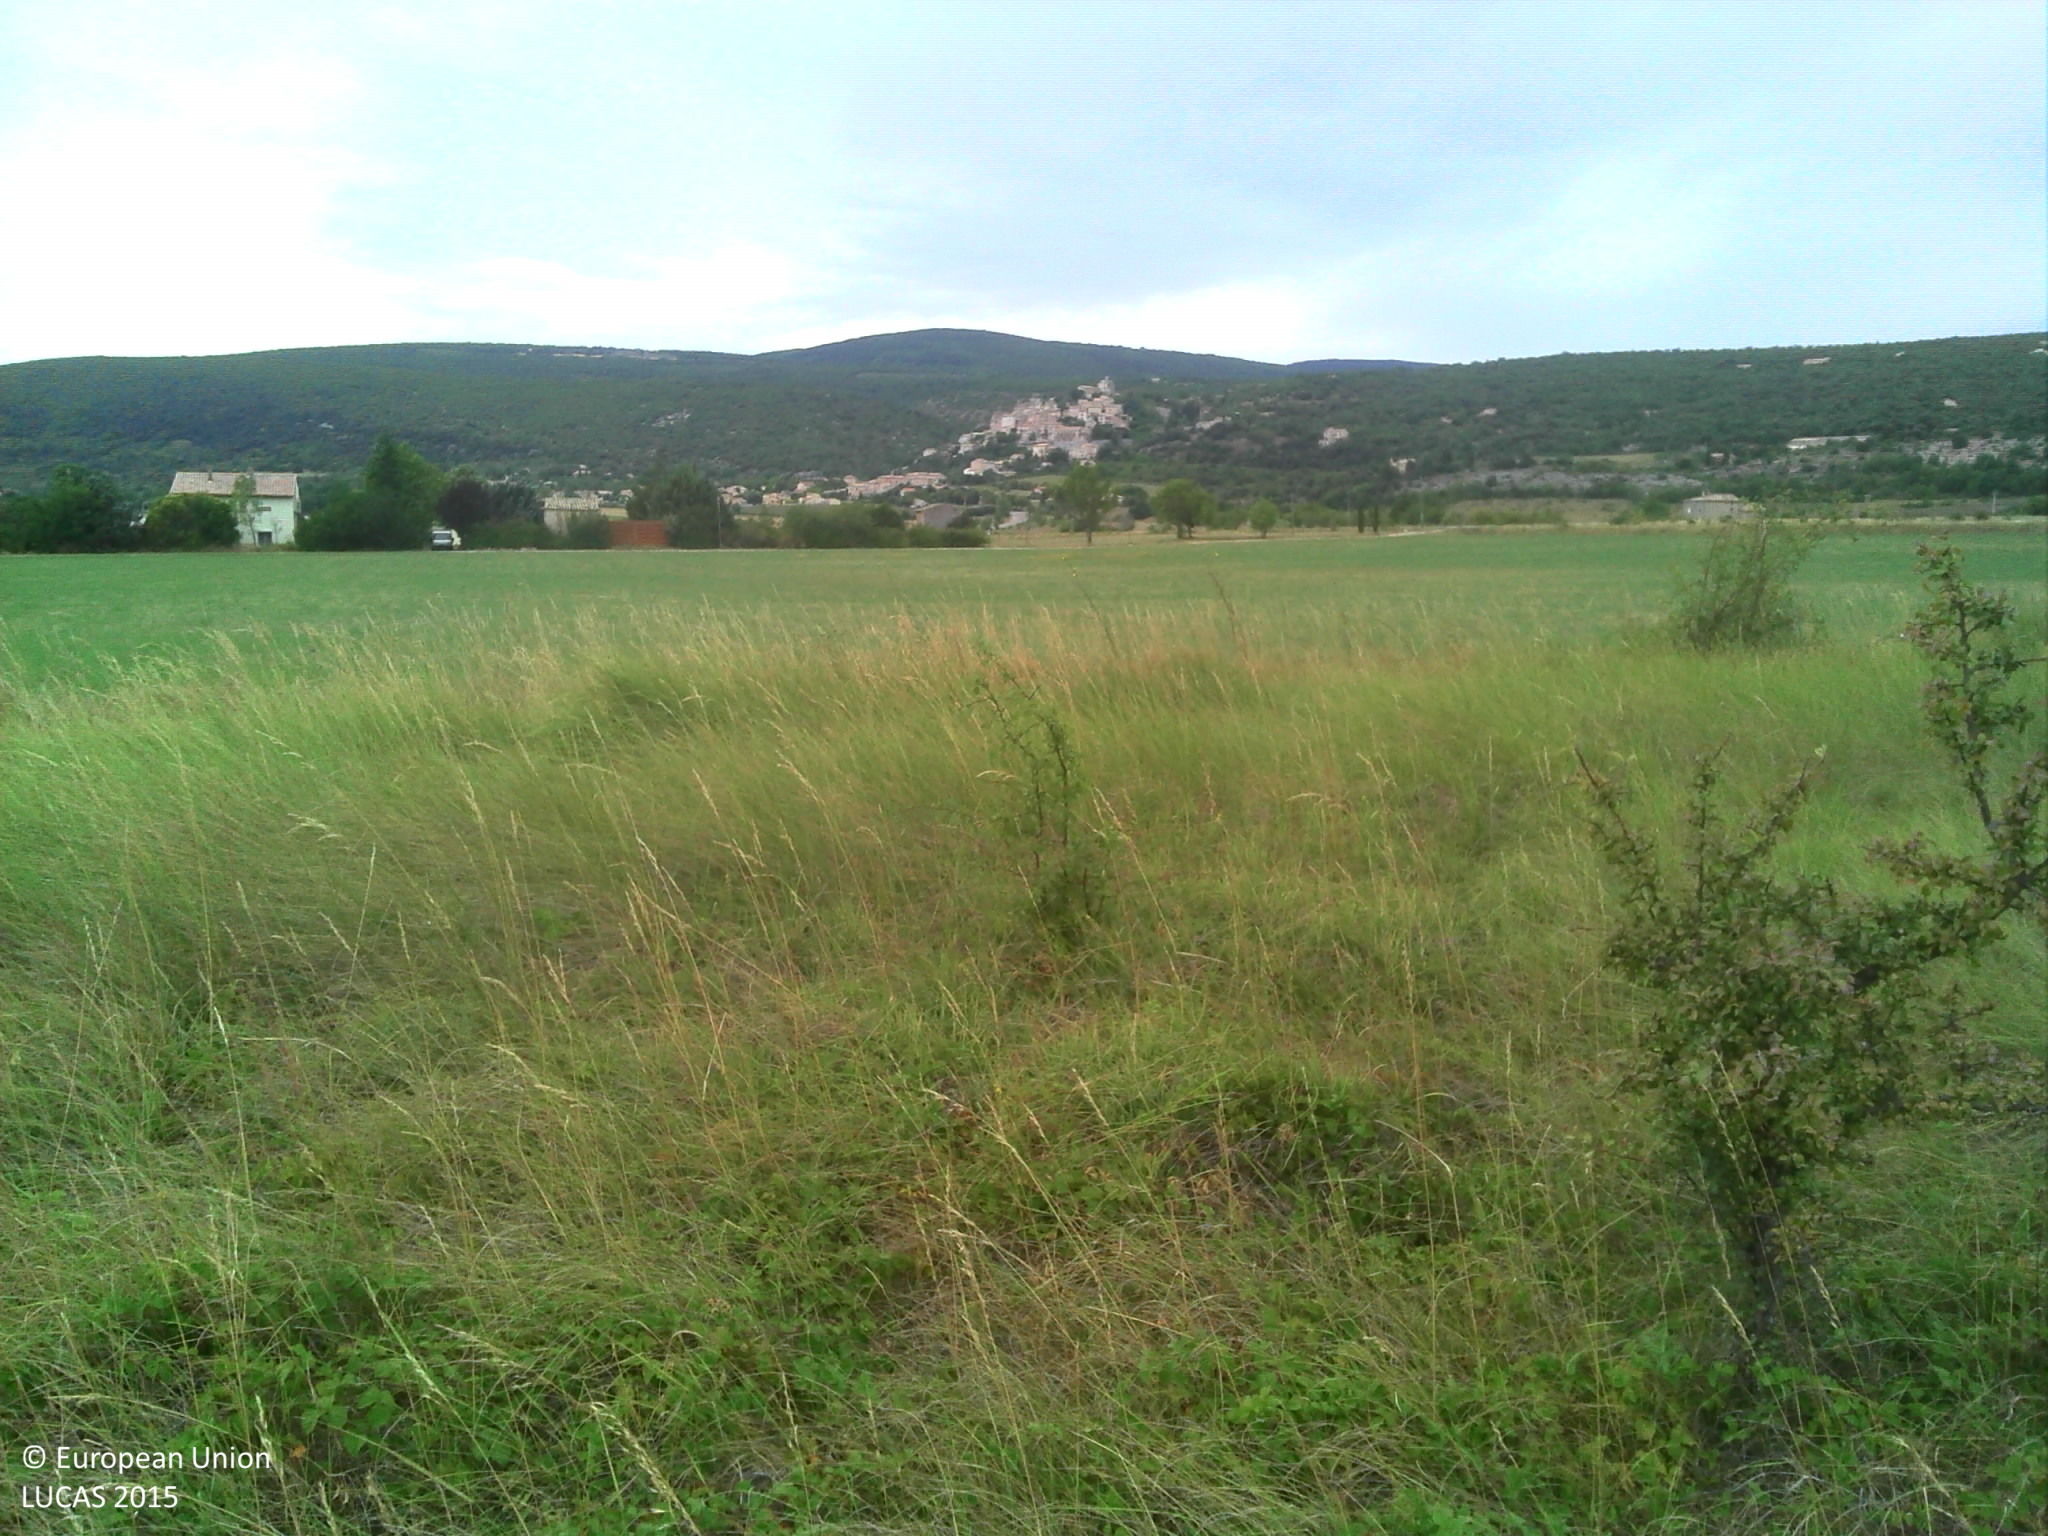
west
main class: Grassland
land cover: Grassland with sparse tree/shrub cover
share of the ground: > 75 %
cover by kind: herbaceous plants 95 %, broadleaved forest trees 5 %
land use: Semi-natural and natural areas not in use
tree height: < 5 m
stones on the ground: < 10 %
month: July
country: FR
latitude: 43.9856
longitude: 5.5822
